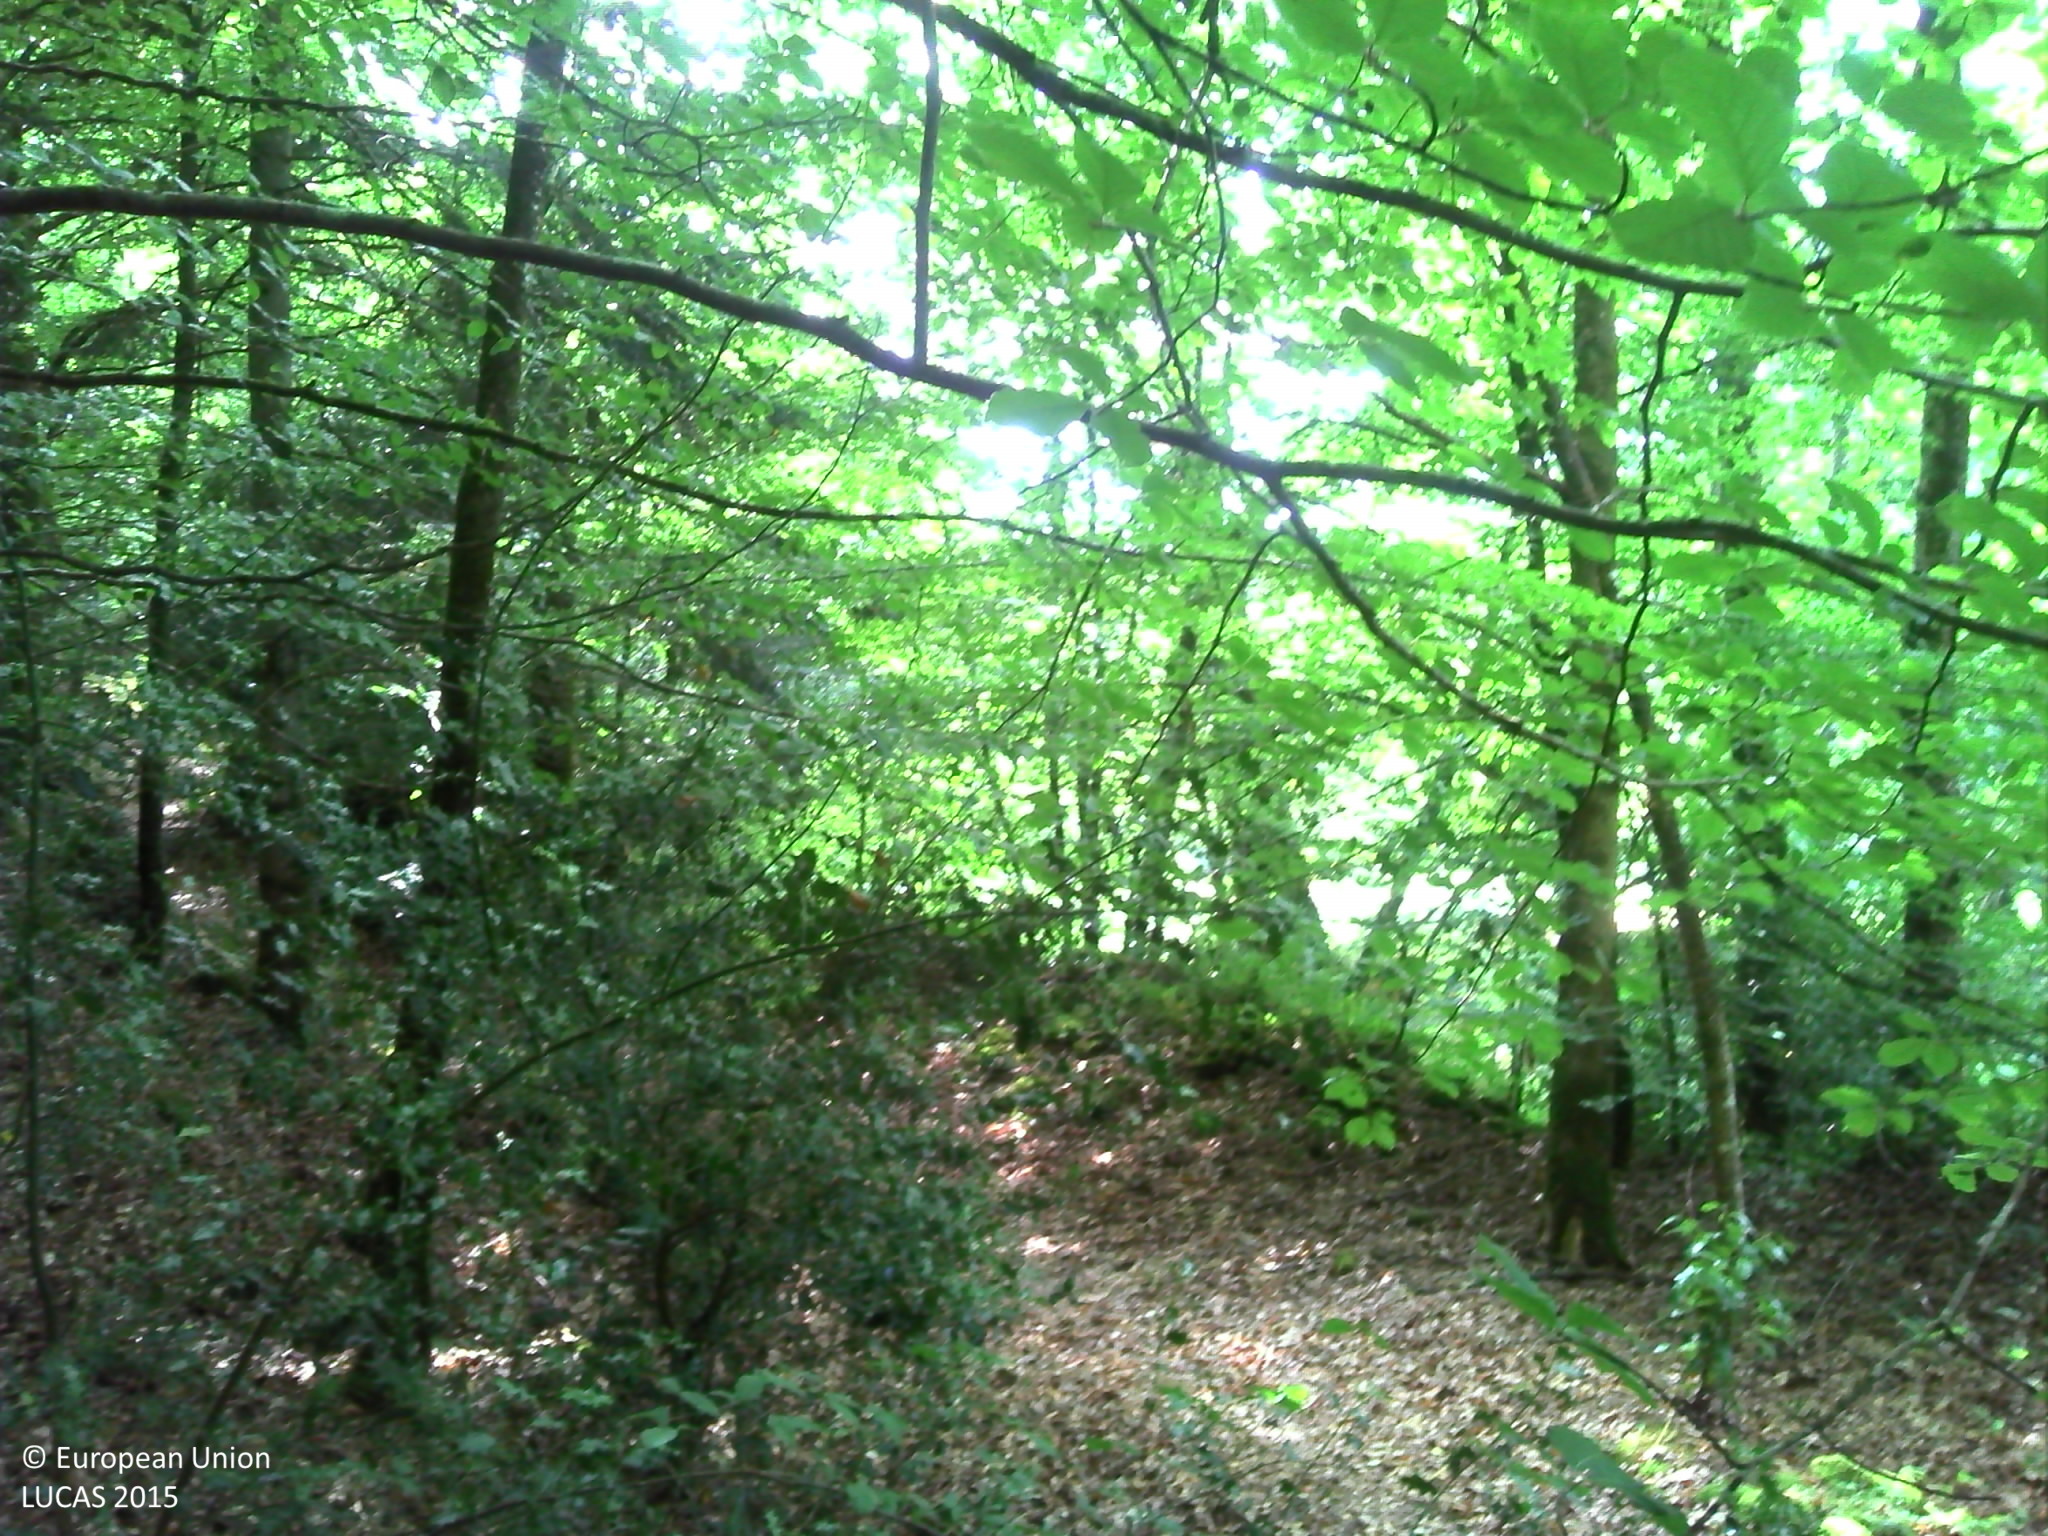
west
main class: Woodland
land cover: Broadleaved woodland
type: acidophilous oak and oak-birch forest
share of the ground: > 75 %
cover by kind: broadleaved forest trees 60 %, coniferous forest trees 10 %, shrubs 10 %, herbaceous plants 10 %, consolidated bare surface 10 %
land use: Forestry
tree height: > 5 m
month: July
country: FR
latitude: 47.9068
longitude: -3.1405
